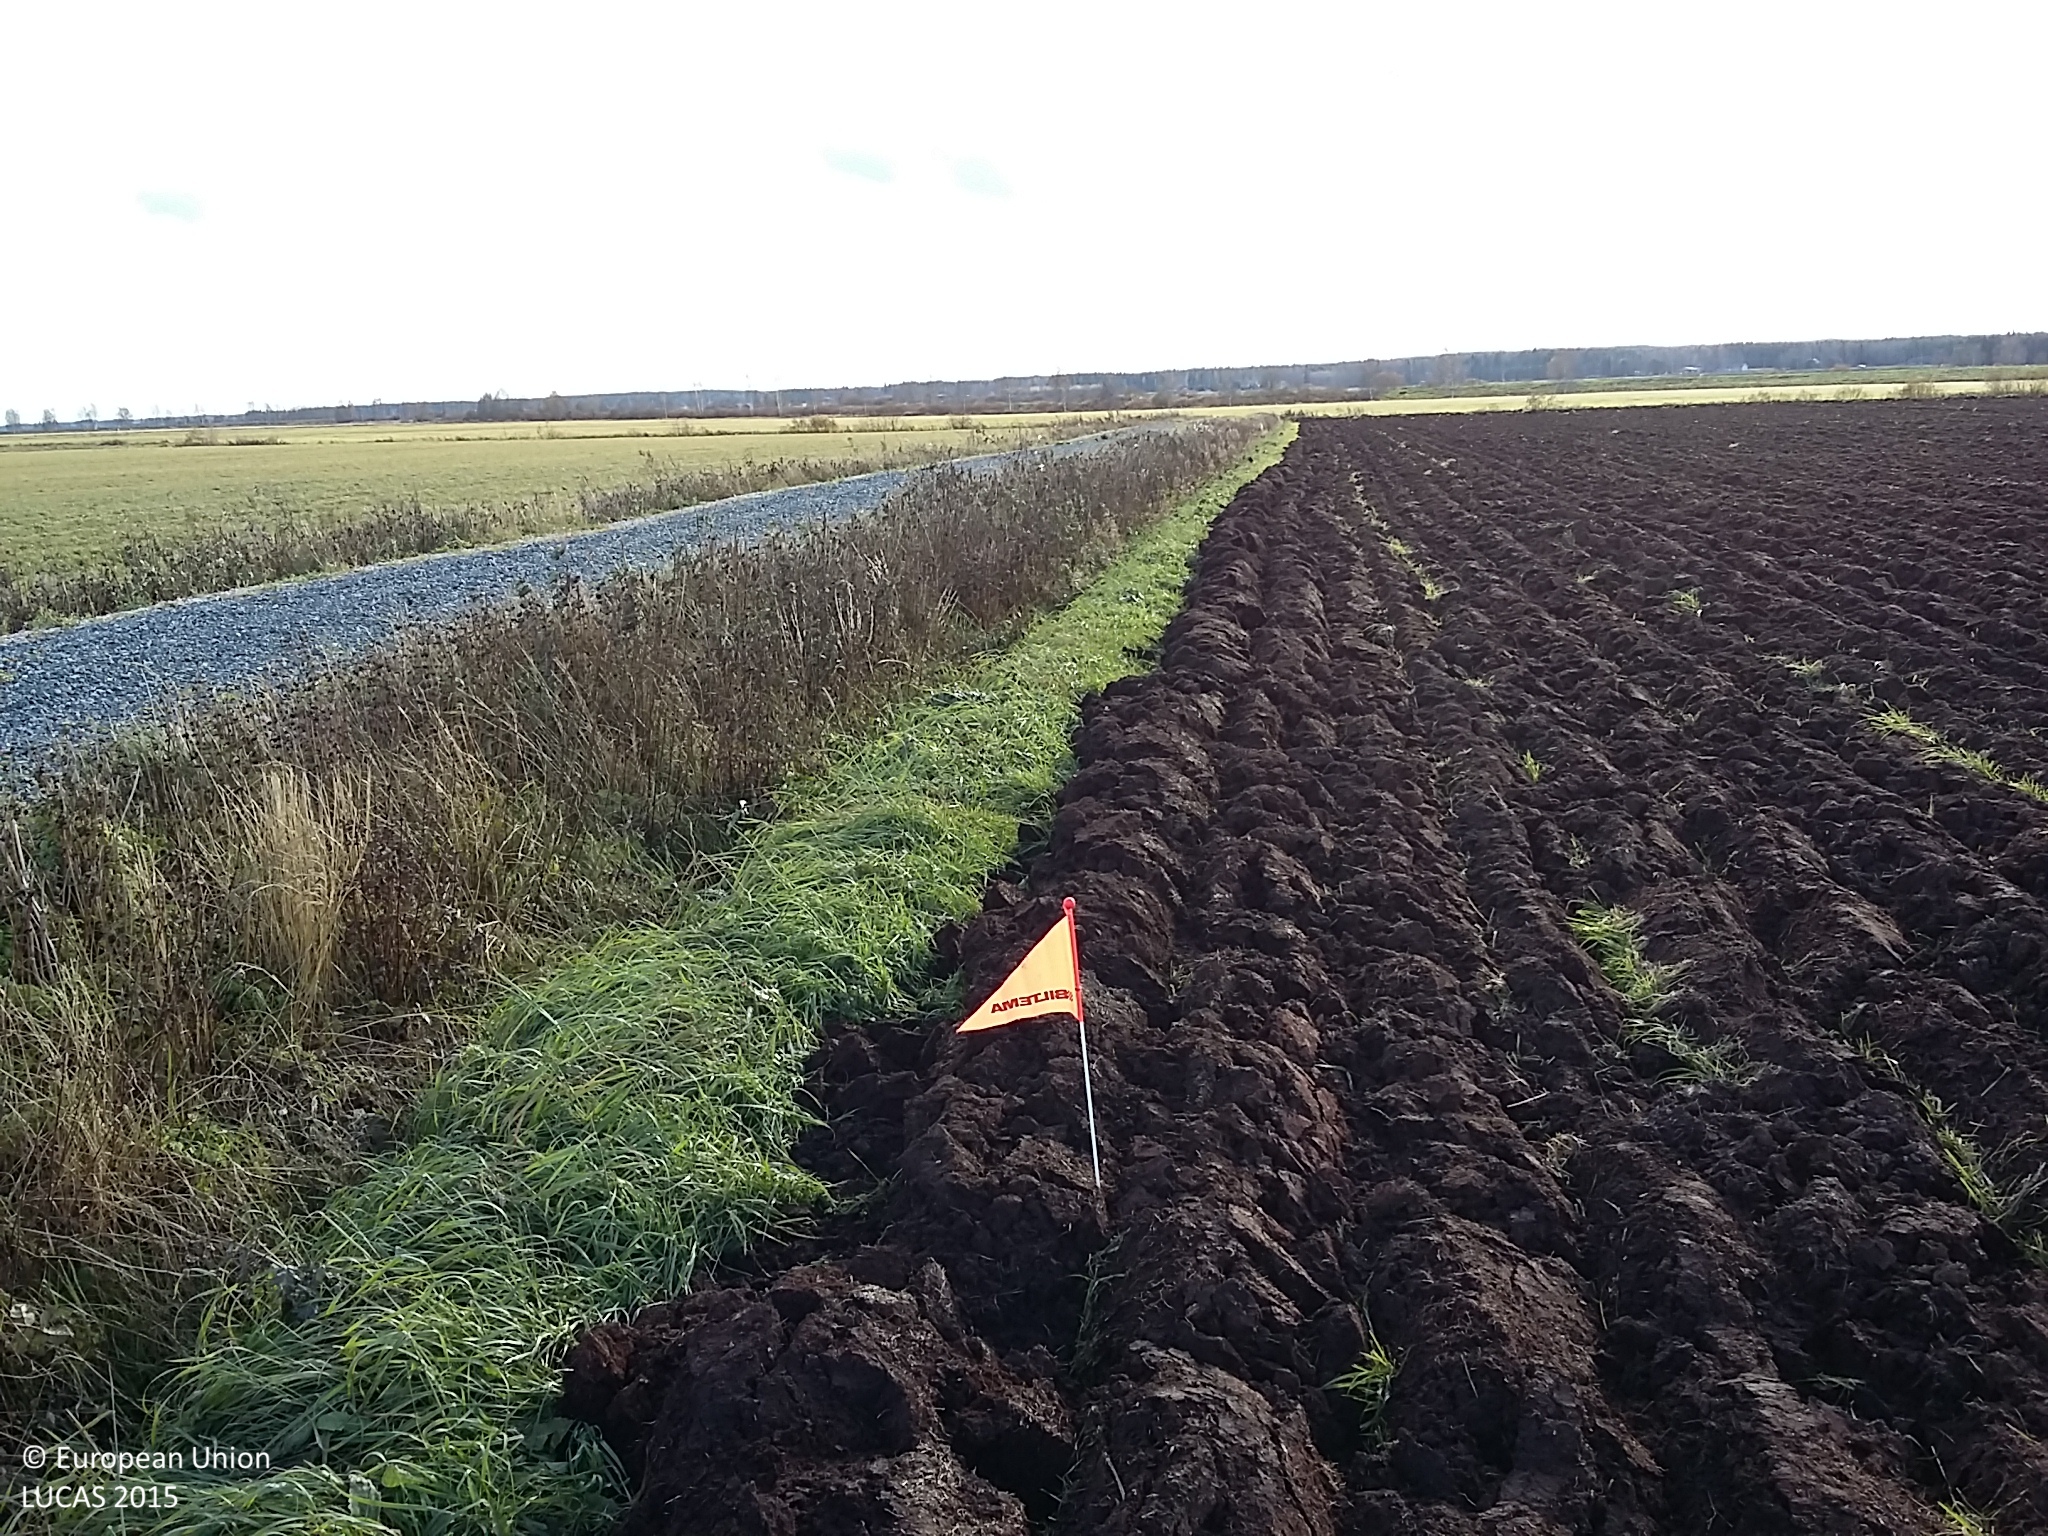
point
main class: Cropland
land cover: Temporary grasslands
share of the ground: > 75 %
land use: Agriculture (excluding fallow land and kitchen gardens)
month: October
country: FI
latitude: 63.9280
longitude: 24.9097
